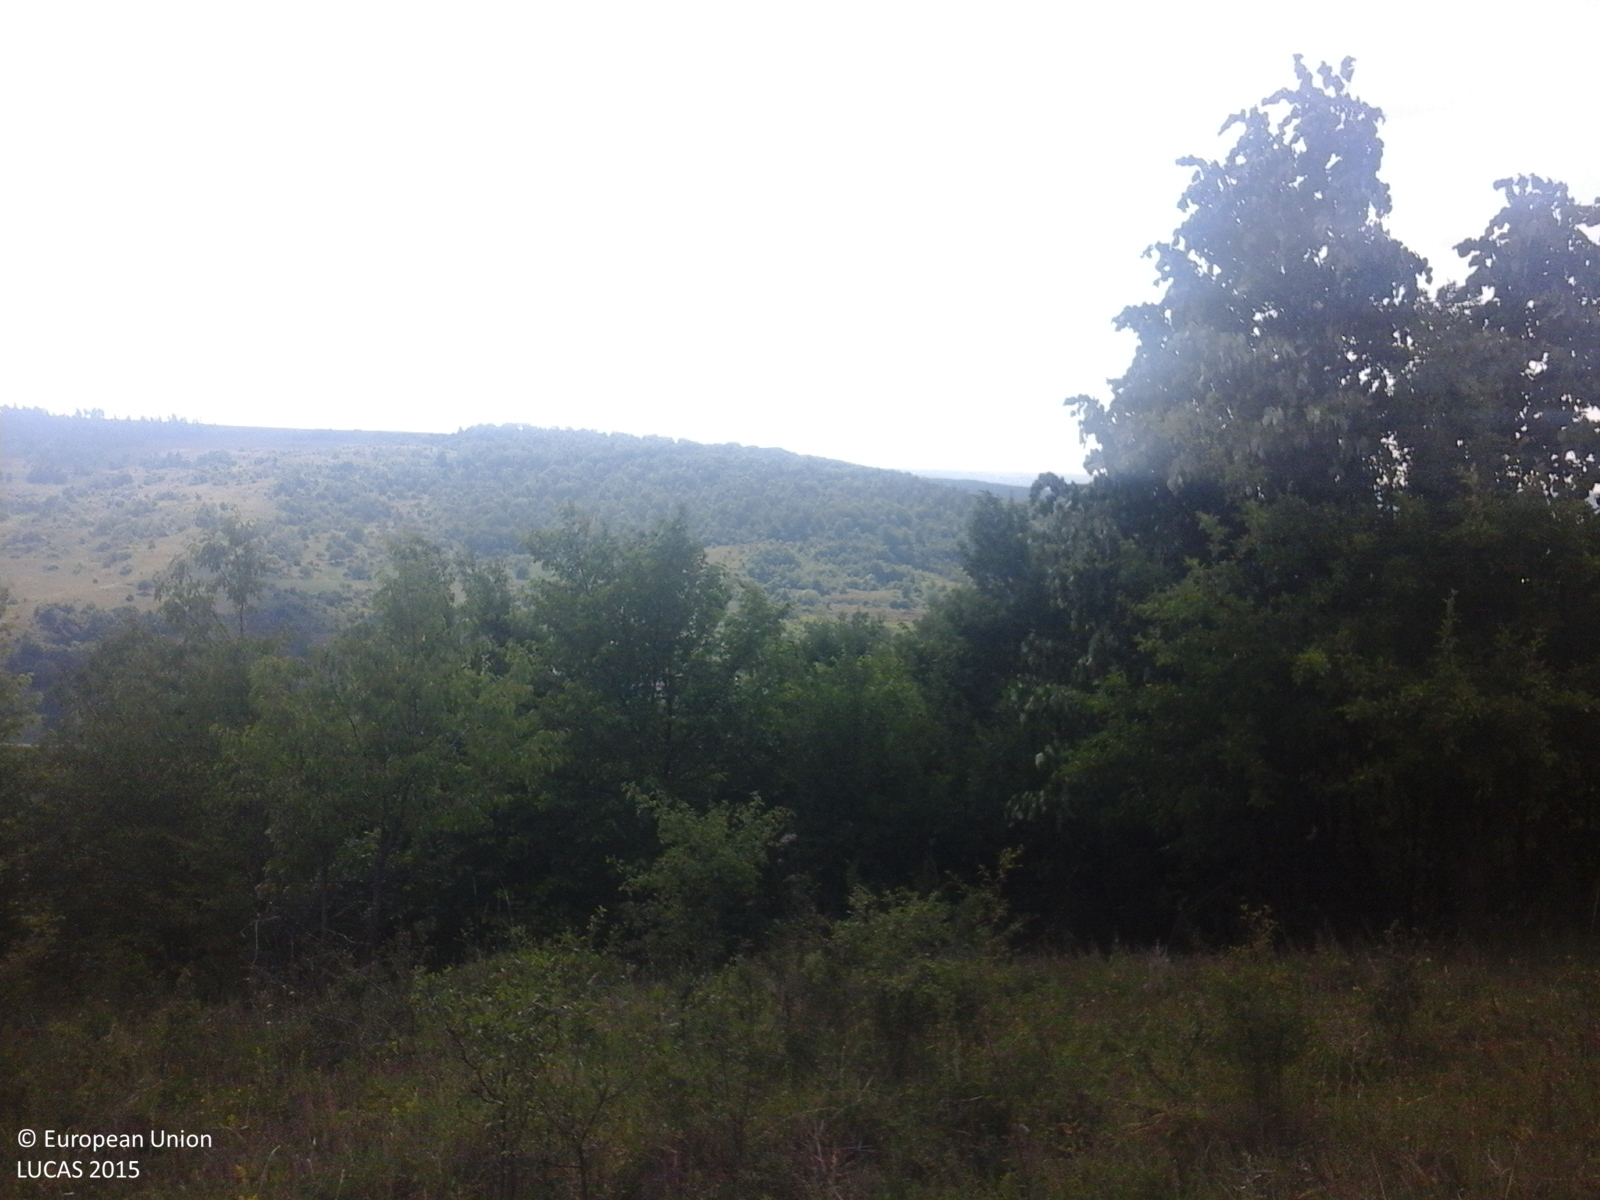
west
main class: Cropland
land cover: Other fruit trees and berries
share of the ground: 50 - 75 %
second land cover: Grassland without tree/shrub cover
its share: > 75 %
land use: Agriculture (excluding fallow land and kitchen gardens)
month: June
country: RO
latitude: 46.7889
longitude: 27.1720
